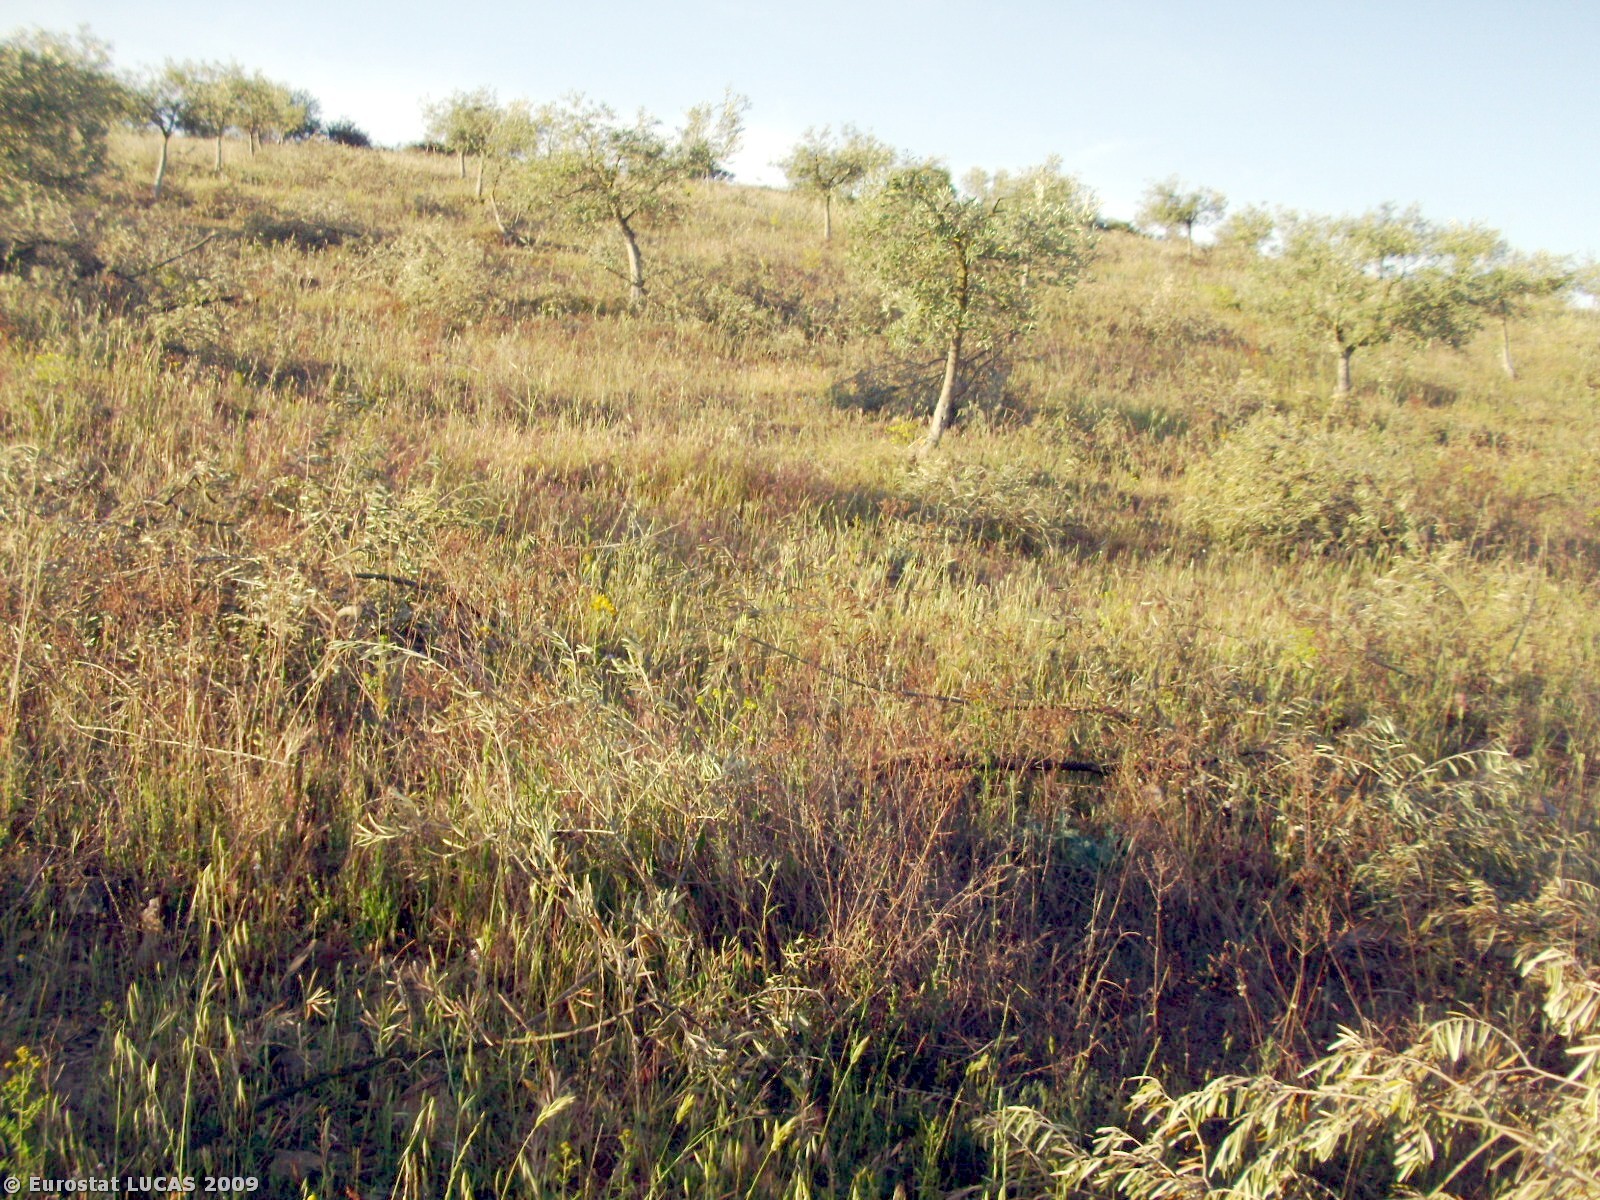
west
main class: Cropland
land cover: Olive groves
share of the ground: 25 - 50 %
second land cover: Spontaneously vegetated surfaces
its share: > 75 %
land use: Agriculture (excluding fallow land and kitchen gardens)
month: May
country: PT
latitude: 41.0570
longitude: -7.2114
